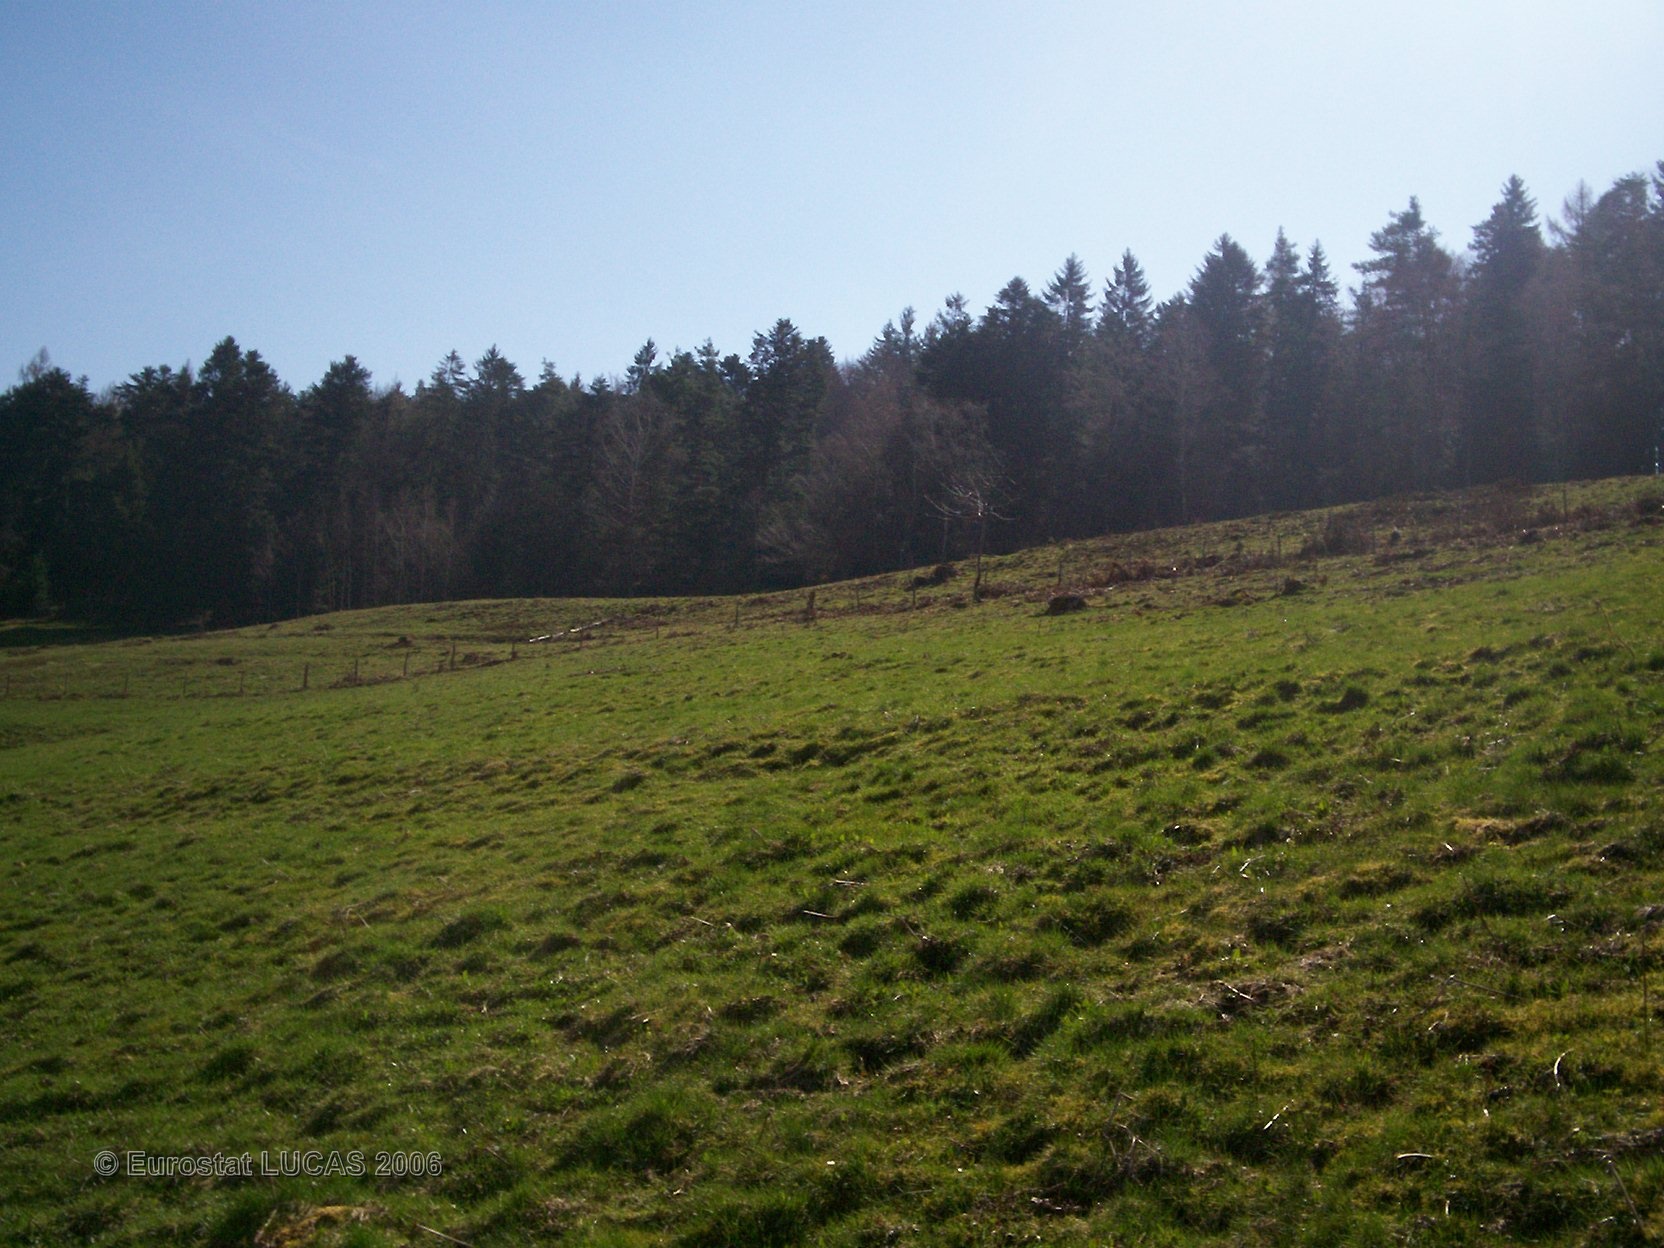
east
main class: Grassland
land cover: Grassland without tree/shrub cover
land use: Agriculture (excluding fallow land and kitchen gardens)
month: April
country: FR
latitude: 48.0411
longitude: 7.0905
